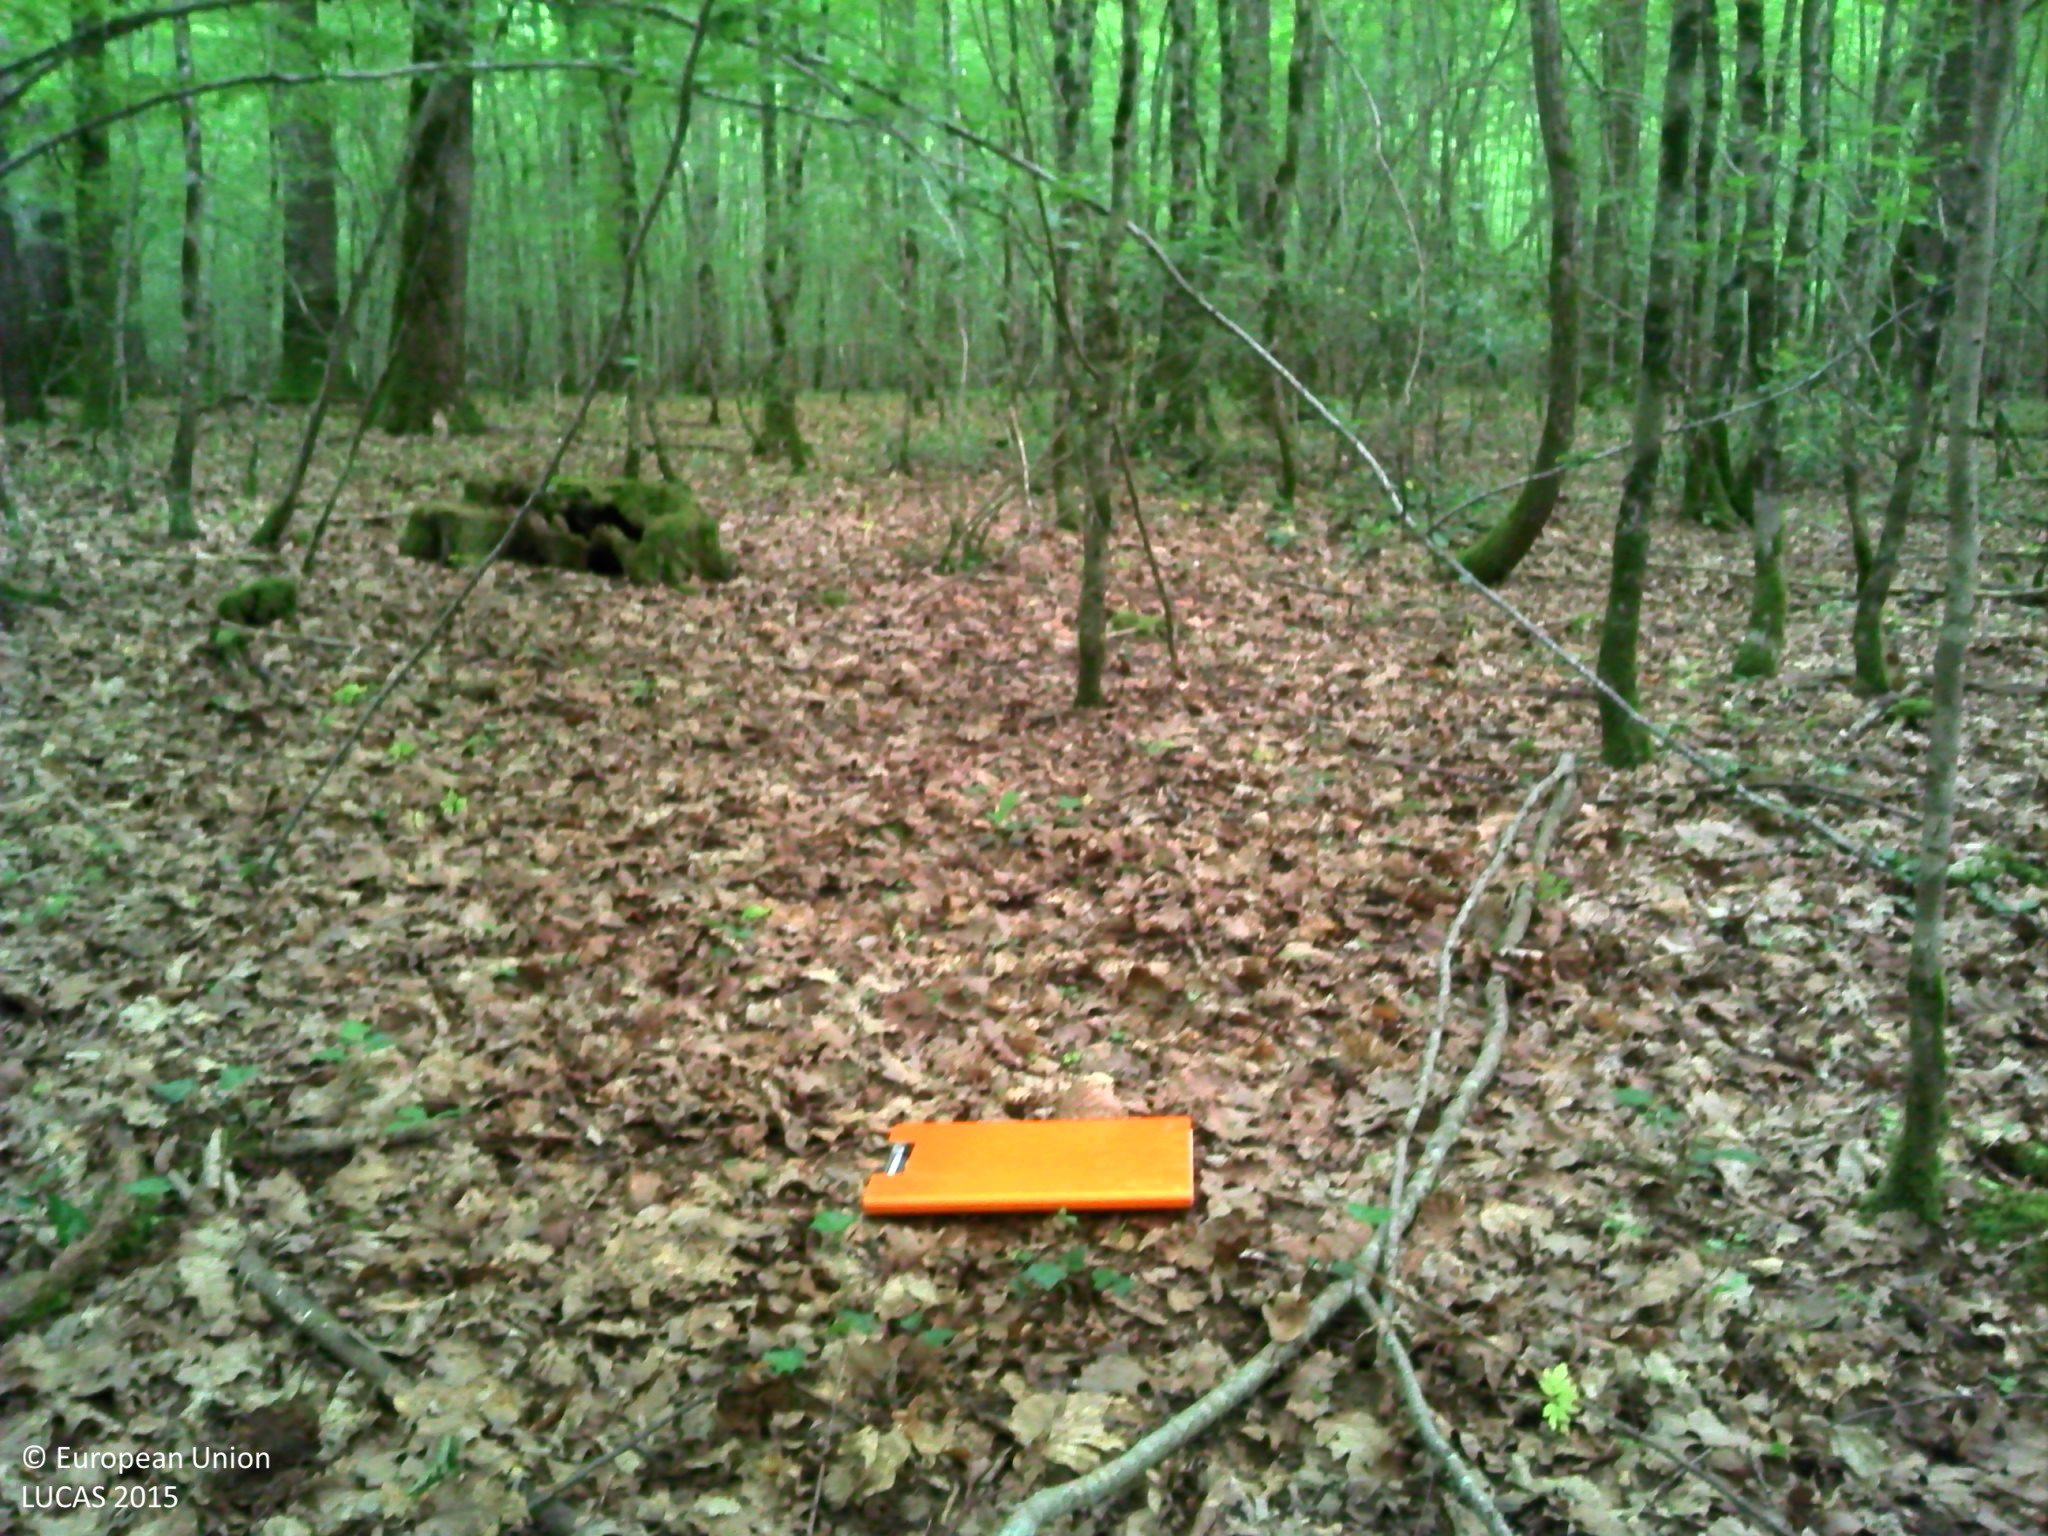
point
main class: Woodland
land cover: Broadleaved woodland
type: mesophytic deciduous forest
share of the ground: > 75 %
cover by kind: broadleaved forest trees 90 %, herbaceous plants 10 %
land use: Forestry
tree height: > 5 m
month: June
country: FR
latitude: 48.5404
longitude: 4.9462
